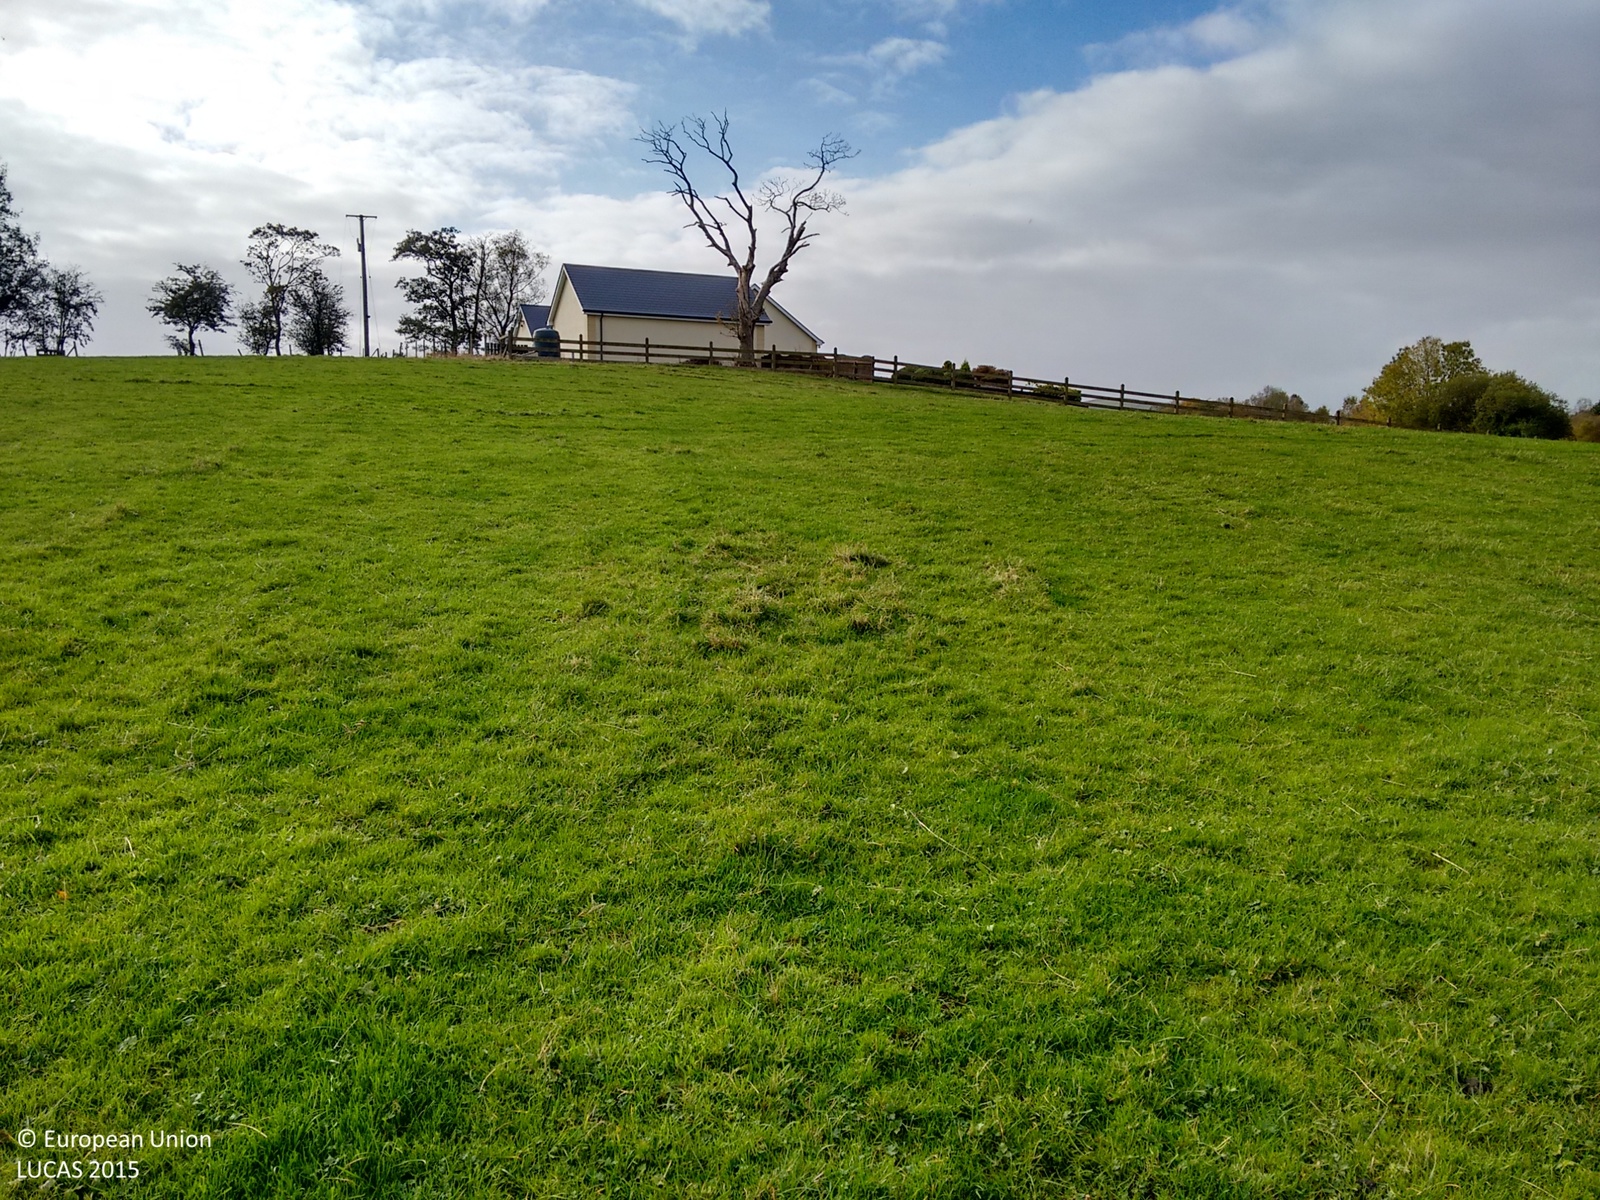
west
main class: Grassland
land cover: Grassland without tree/shrub cover
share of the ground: > 75 %
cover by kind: herbaceous plants 100 %
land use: Agriculture (excluding fallow land and kitchen gardens)
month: October
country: GB
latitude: 54.3919
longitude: -7.4176
